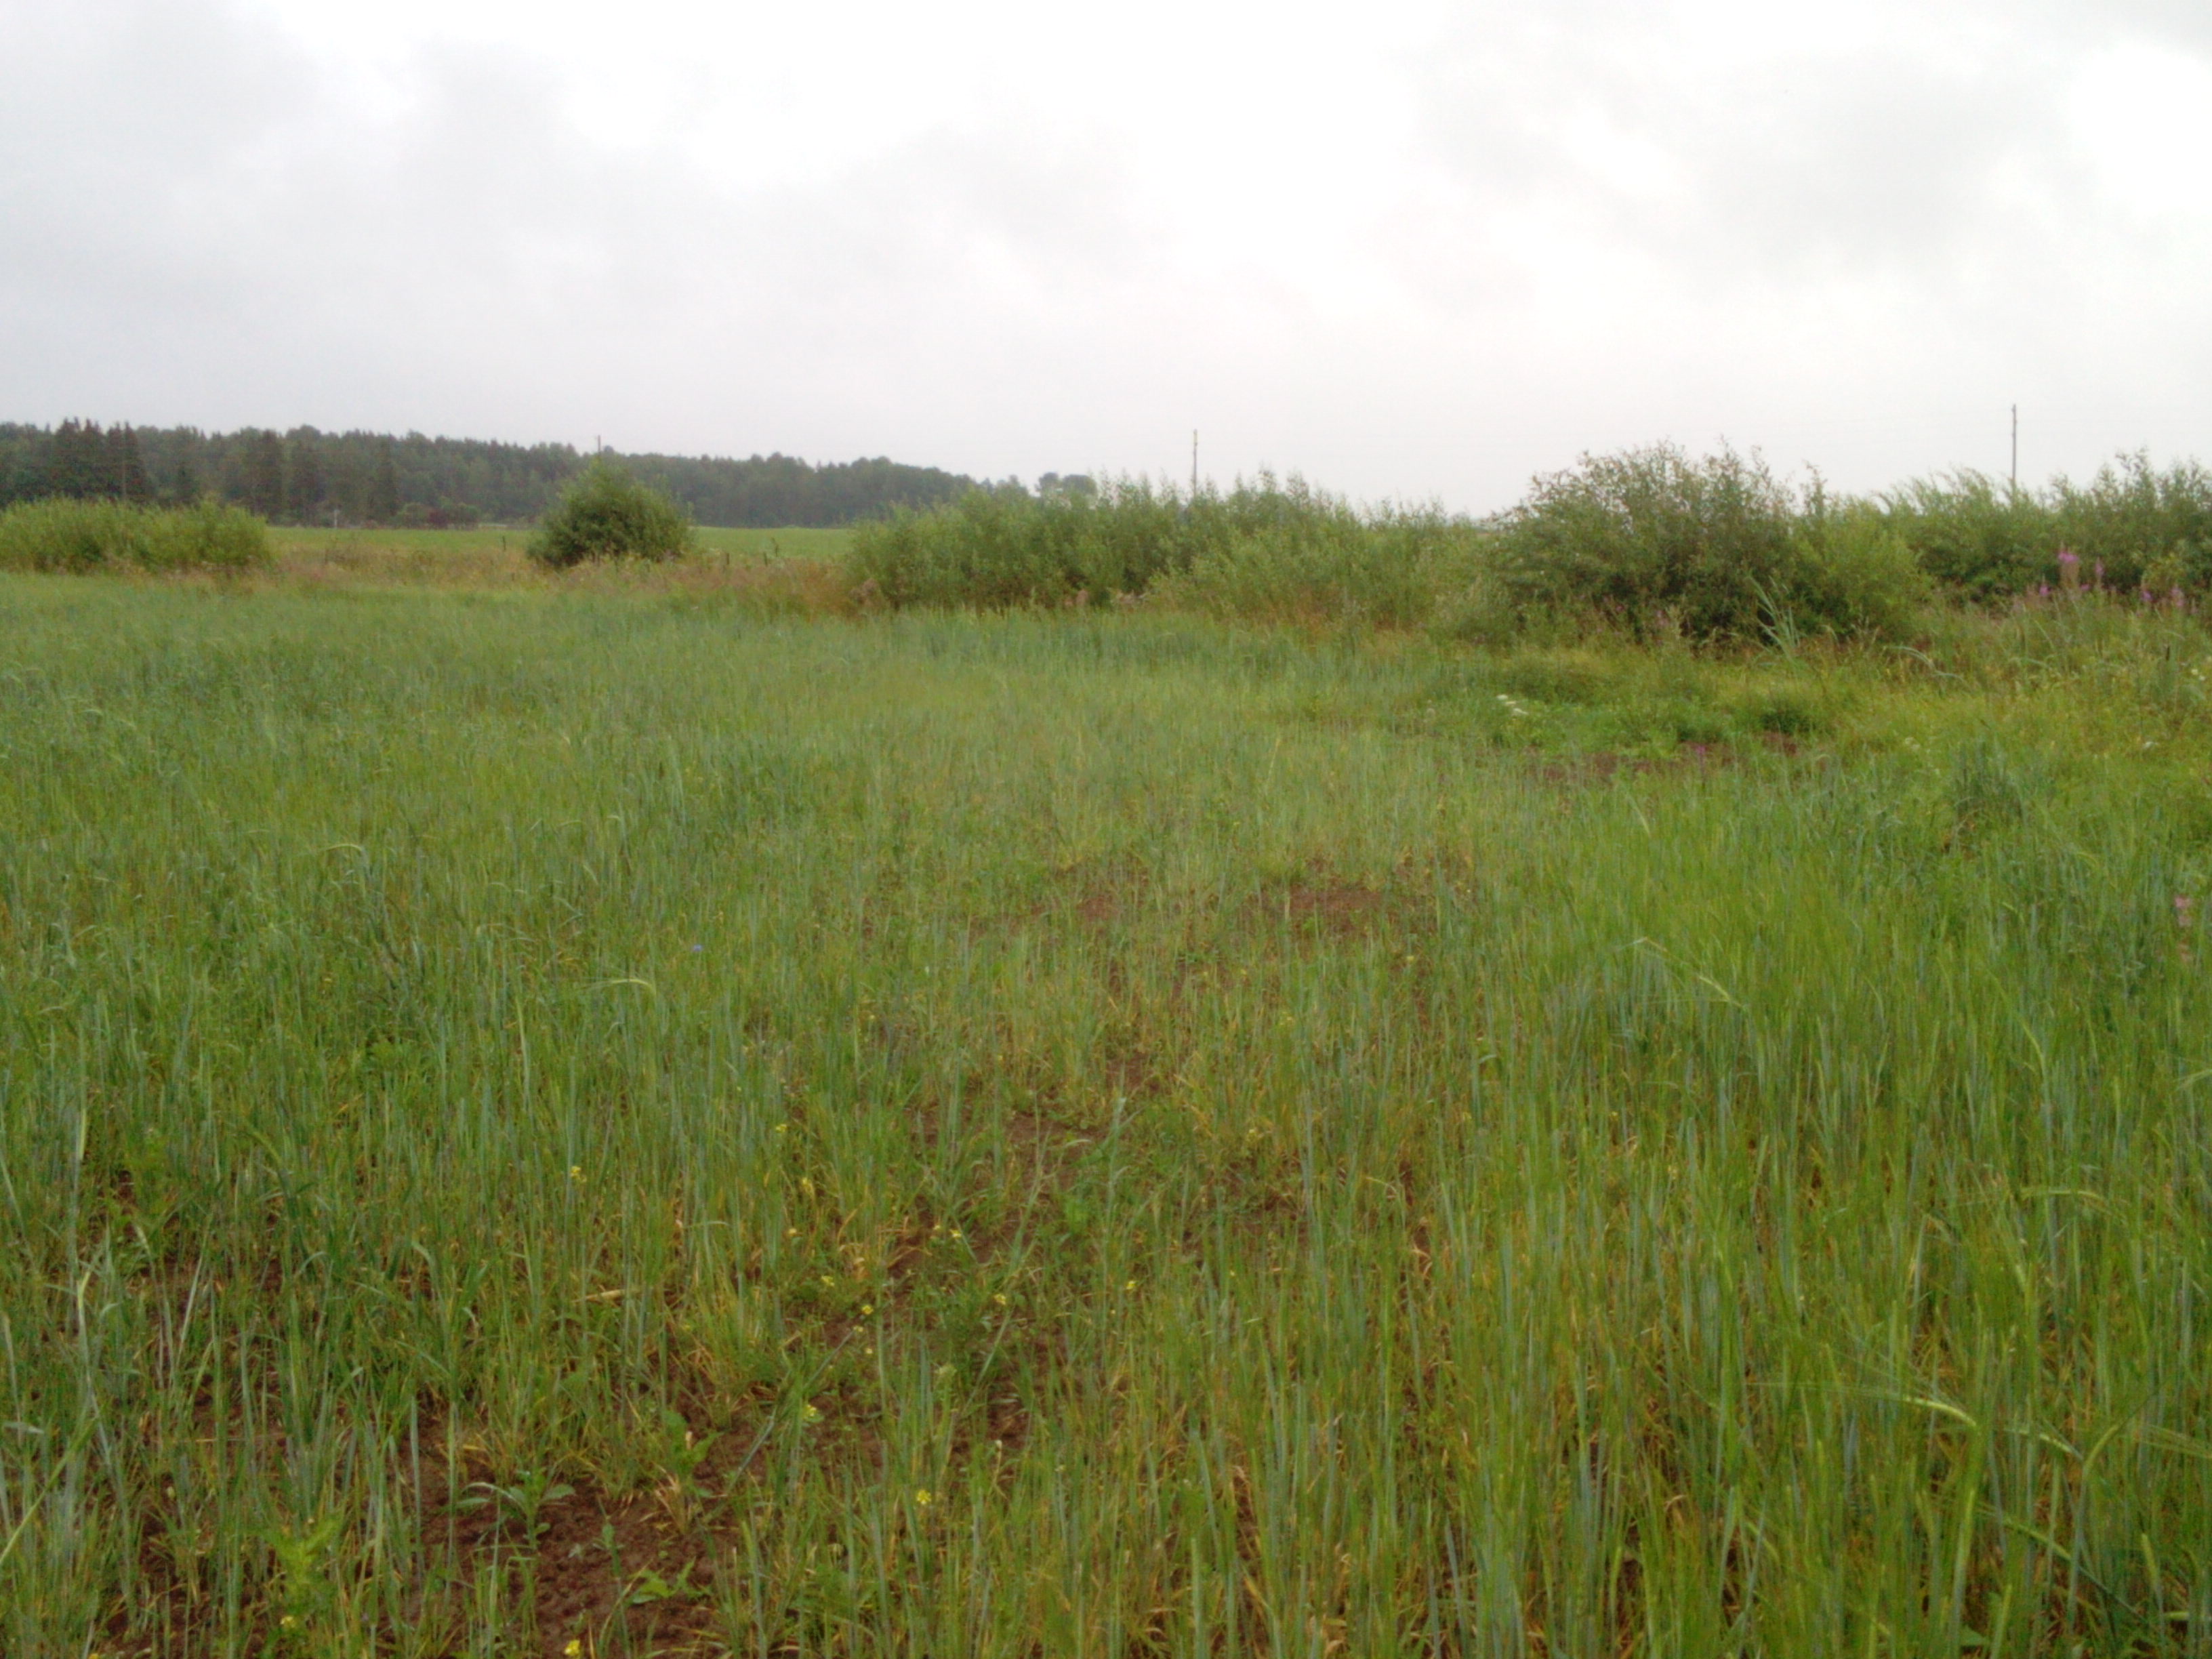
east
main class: Cropland
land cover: Barley
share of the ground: > 75 %
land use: Agriculture (excluding fallow land and kitchen gardens)
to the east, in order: Barley; Abandoned hedges; Ditches and canals; Grass margins; Tracks; Grass margins; Grassland without tree/shrub cover
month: July
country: LV
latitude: 57.0097
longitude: 22.1528
